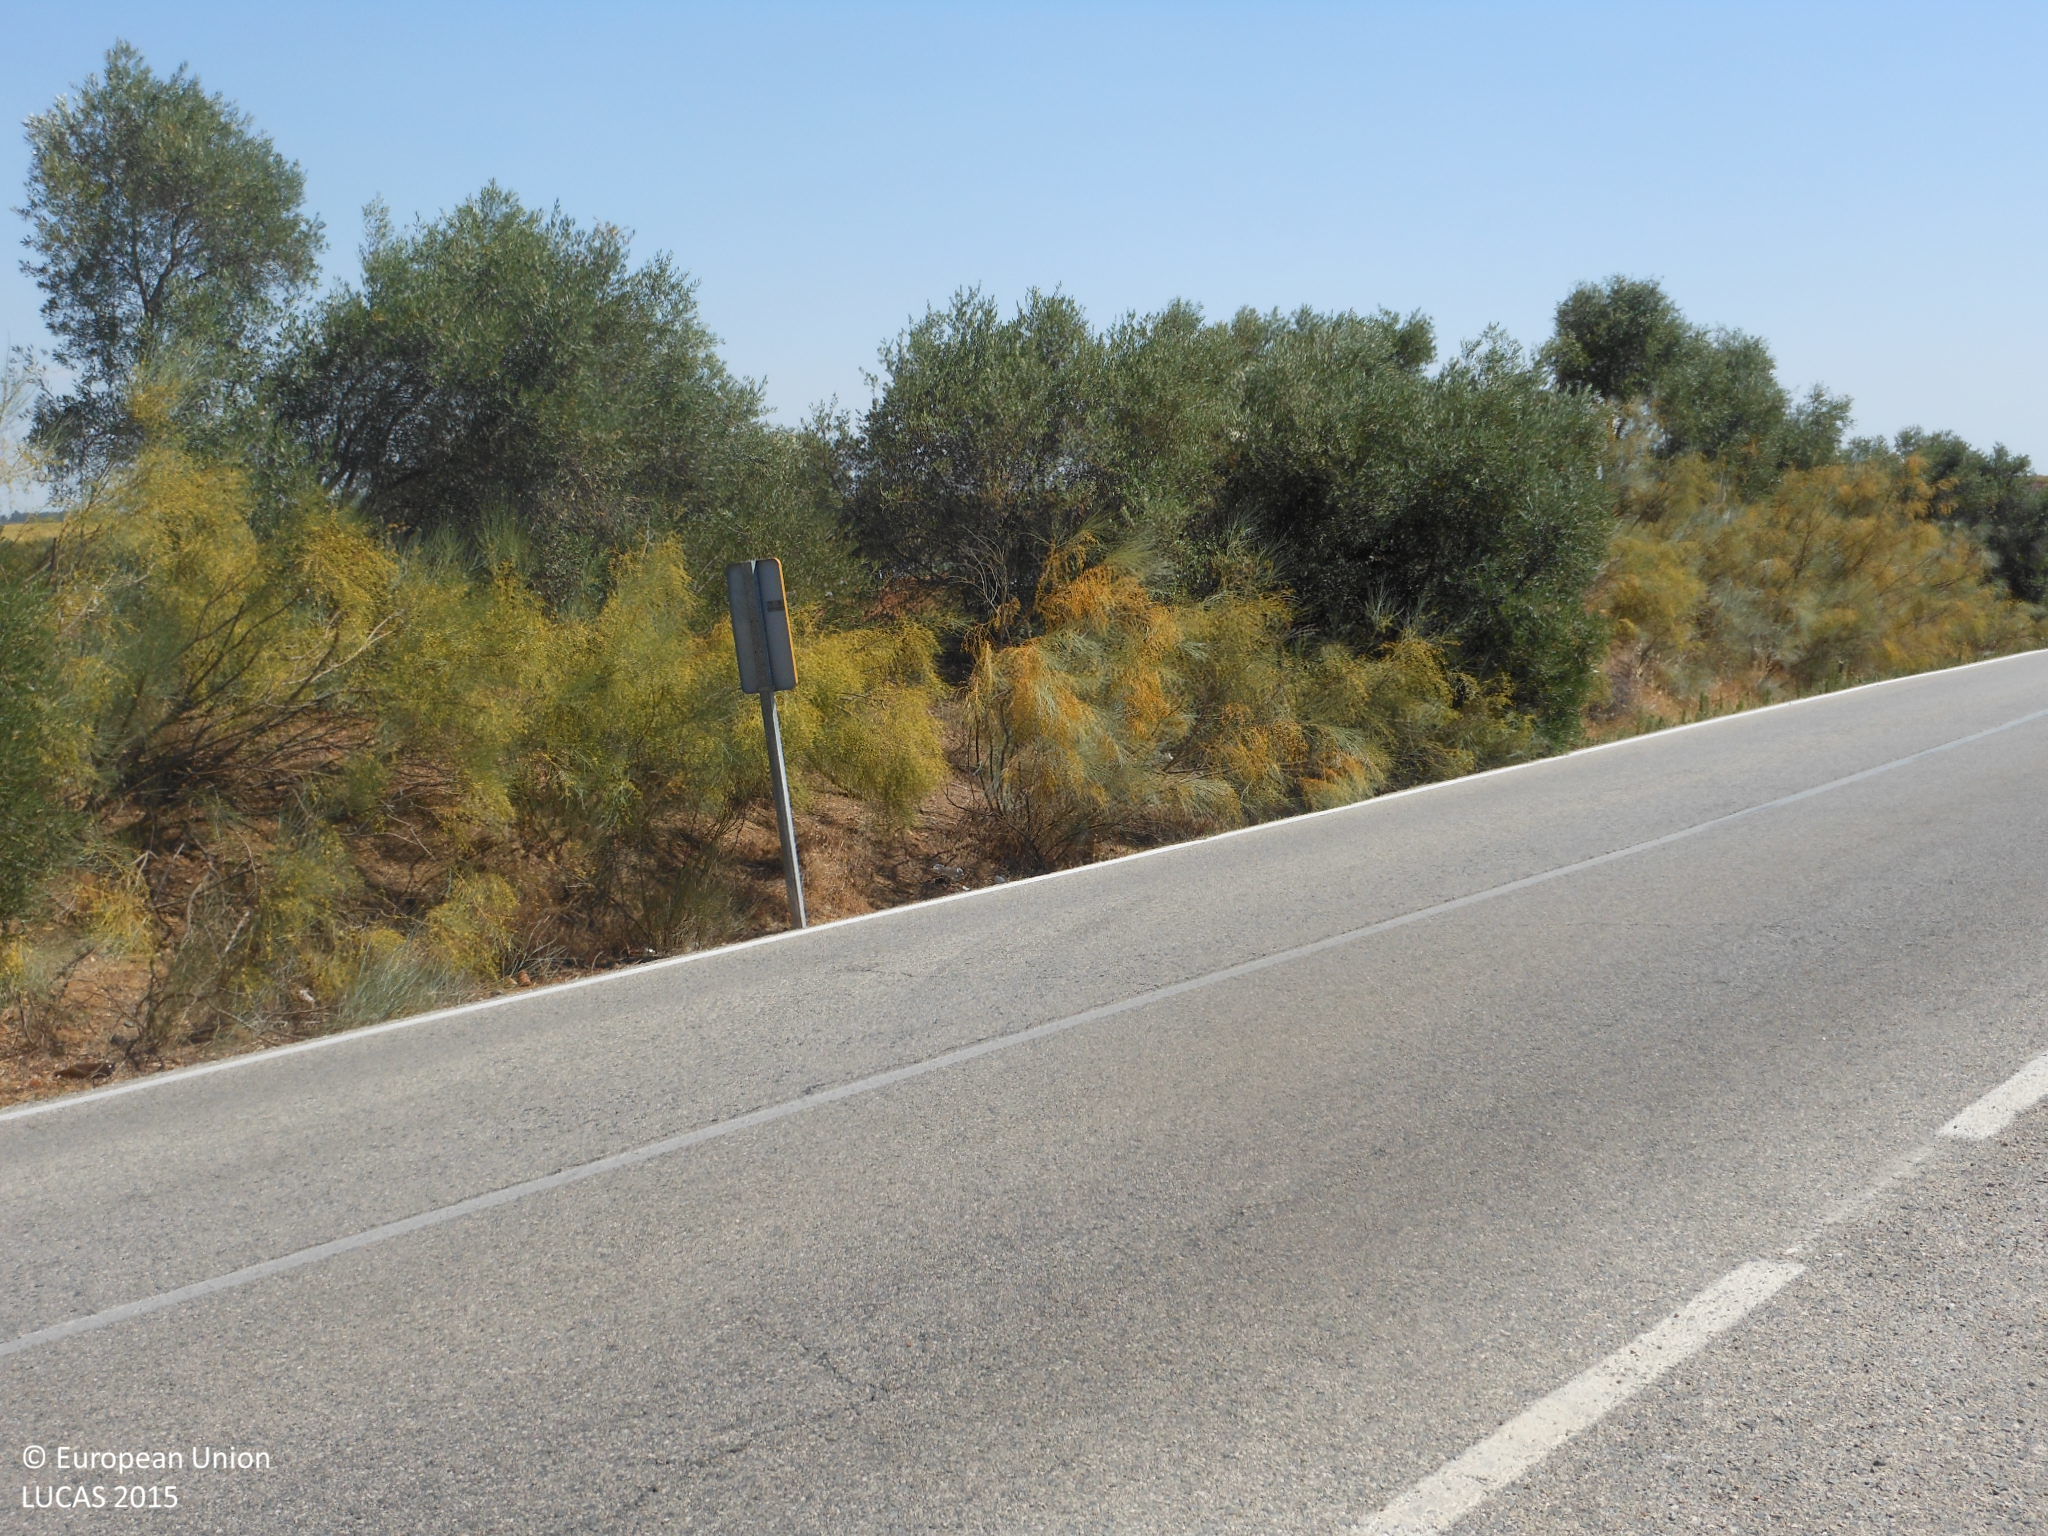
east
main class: Cropland
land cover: Arable land (only in case pi)
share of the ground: > 75 %
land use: Agriculture (excluding fallow land and kitchen gardens)
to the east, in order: Arable land (only in case pi); Grass margins; Tracks; Grass margins; Arable land (only in case pi)
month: June
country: ES
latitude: 37.5348
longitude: -5.5115
